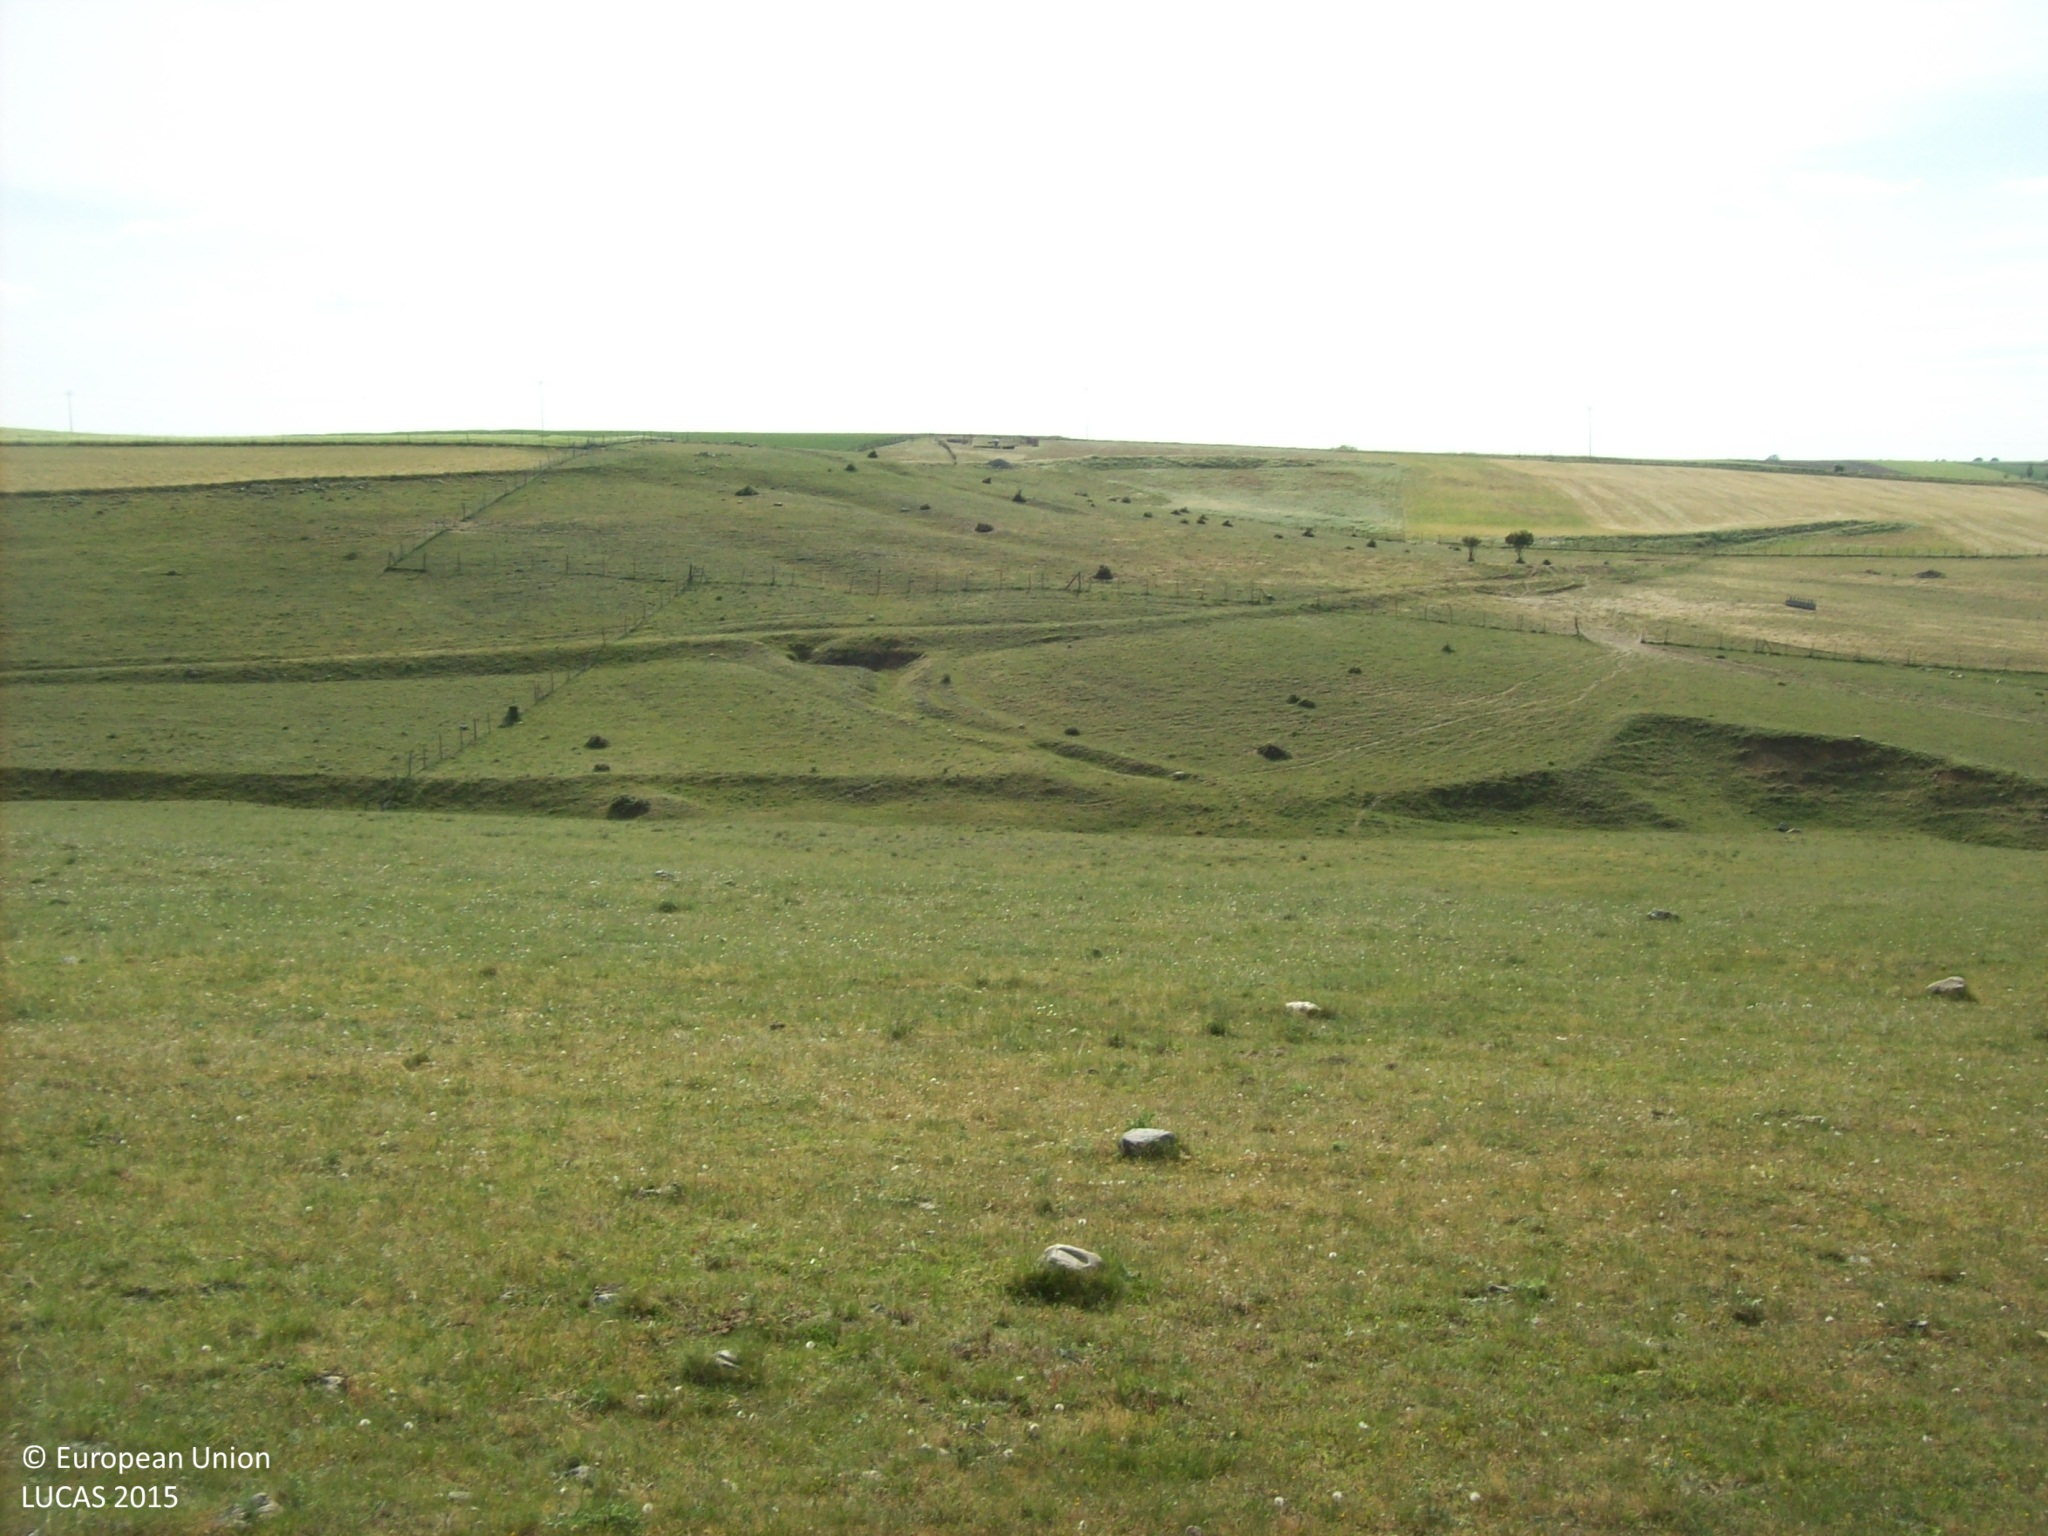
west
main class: Grassland
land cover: Grassland without tree/shrub cover
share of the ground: > 75 %
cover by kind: herbaceous plants 100 %
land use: Agriculture (excluding fallow land and kitchen gardens)
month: May
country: ES
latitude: 40.7976
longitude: -4.5022
